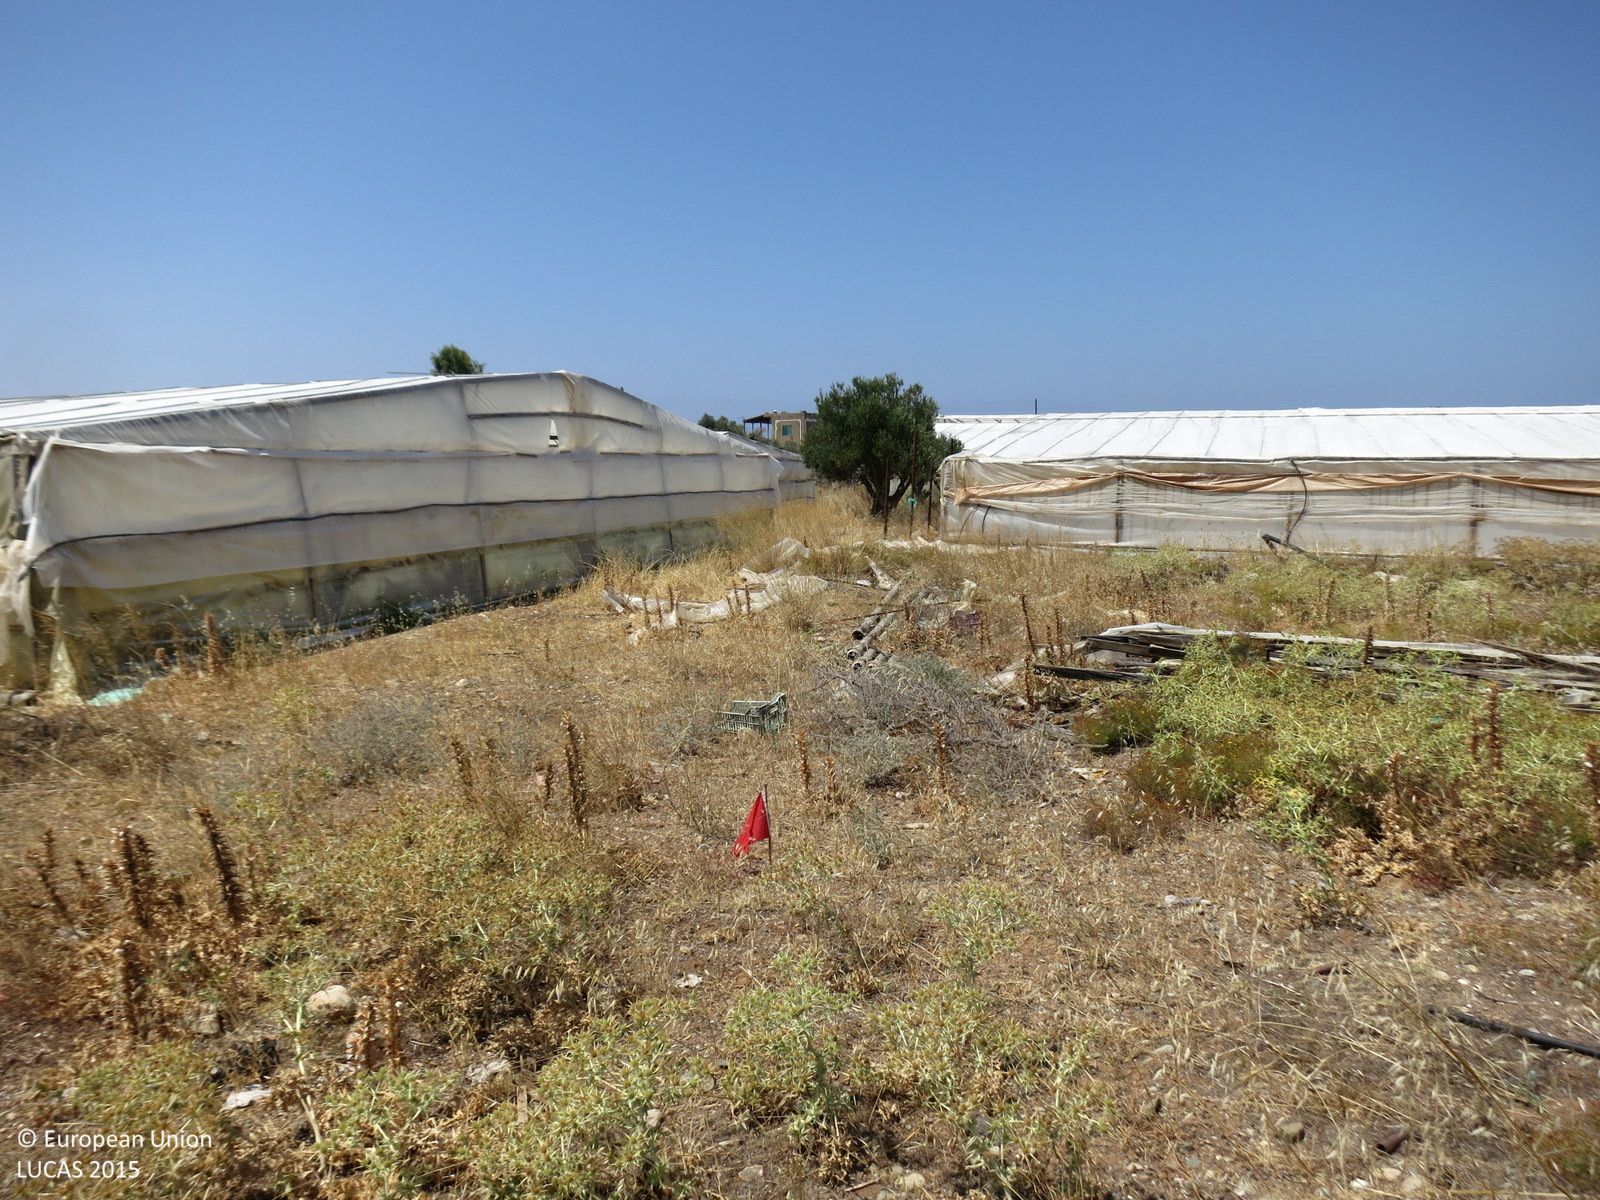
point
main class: Grassland
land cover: Spontaneously vegetated surfaces
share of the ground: > 75 %
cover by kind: herbaceous plants 95 %, shrubs 5 %
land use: Fallow land
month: July
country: GR
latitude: 35.0790
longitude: 24.7571
